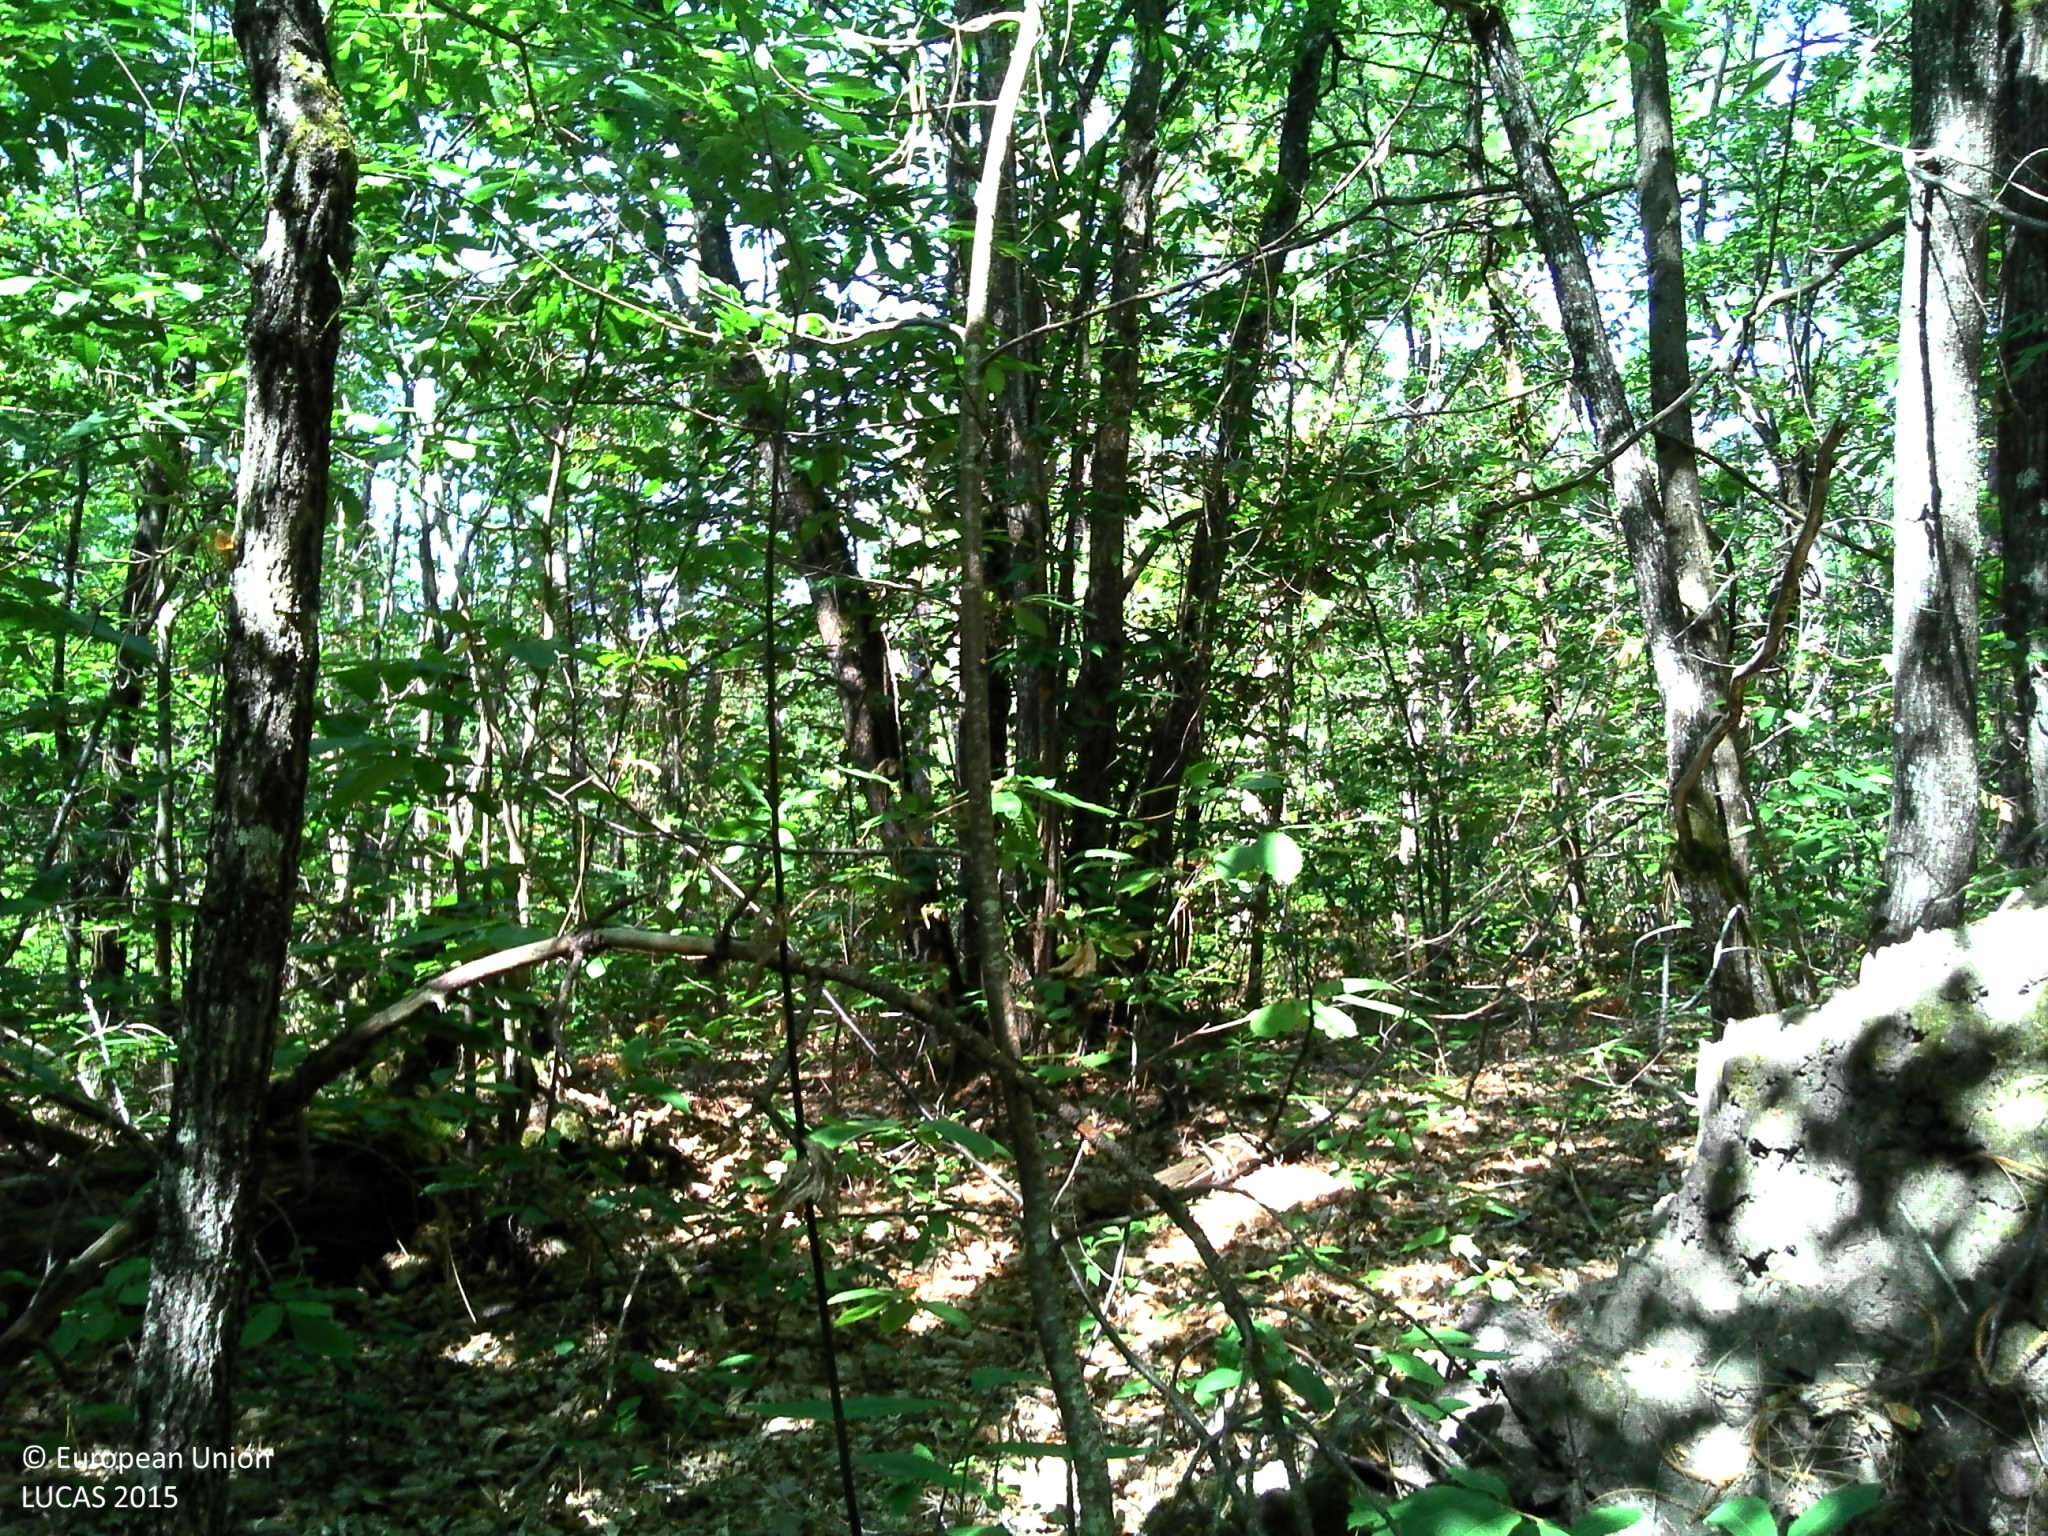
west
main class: Woodland
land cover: Broadleaved woodland
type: acidophilous oak and oak-birch forest
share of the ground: > 75 %
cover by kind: broadleaved forest trees 80 %, herbaceous plants 10 %, shrubs 5 %, lichens and mosses 5 %
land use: Forestry
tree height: > 5 m
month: July
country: FR
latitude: 44.9167
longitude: 0.5530
